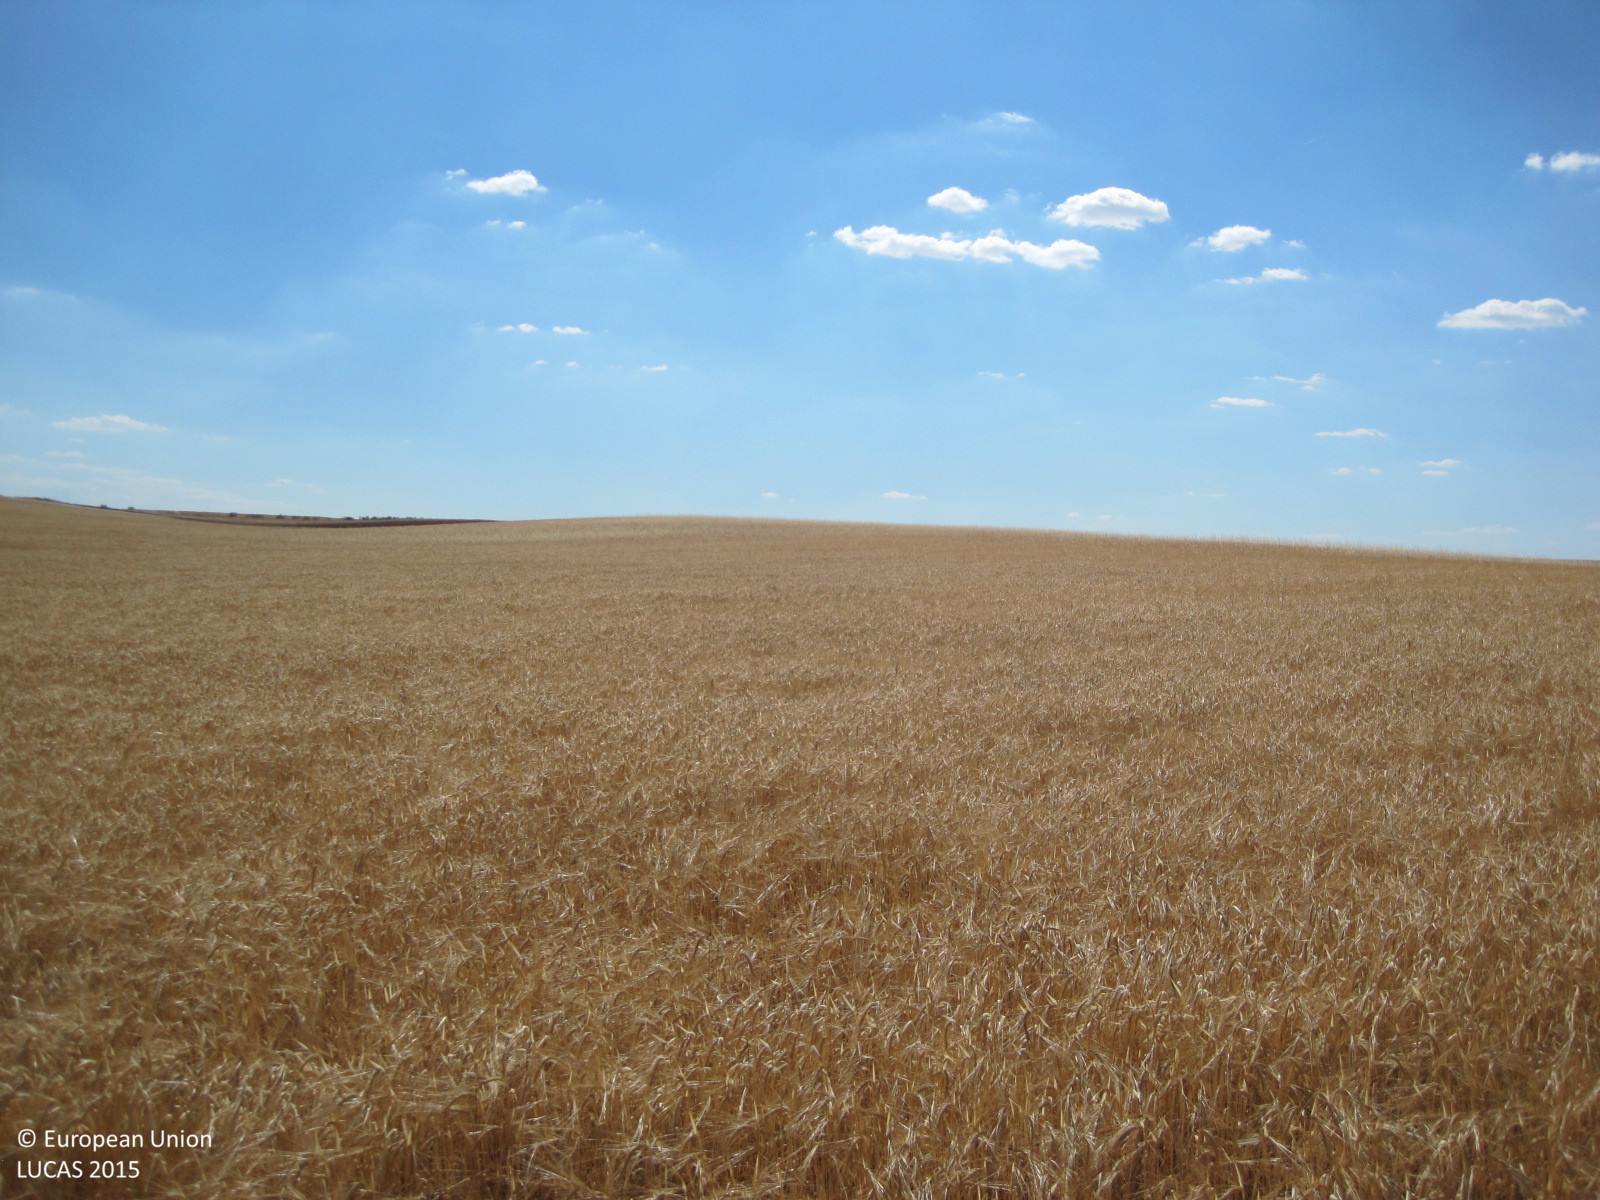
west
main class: Cropland
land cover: Barley
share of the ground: > 75 %
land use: Agriculture (excluding fallow land and kitchen gardens)
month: June
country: ES
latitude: 39.9177
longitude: -4.2530
